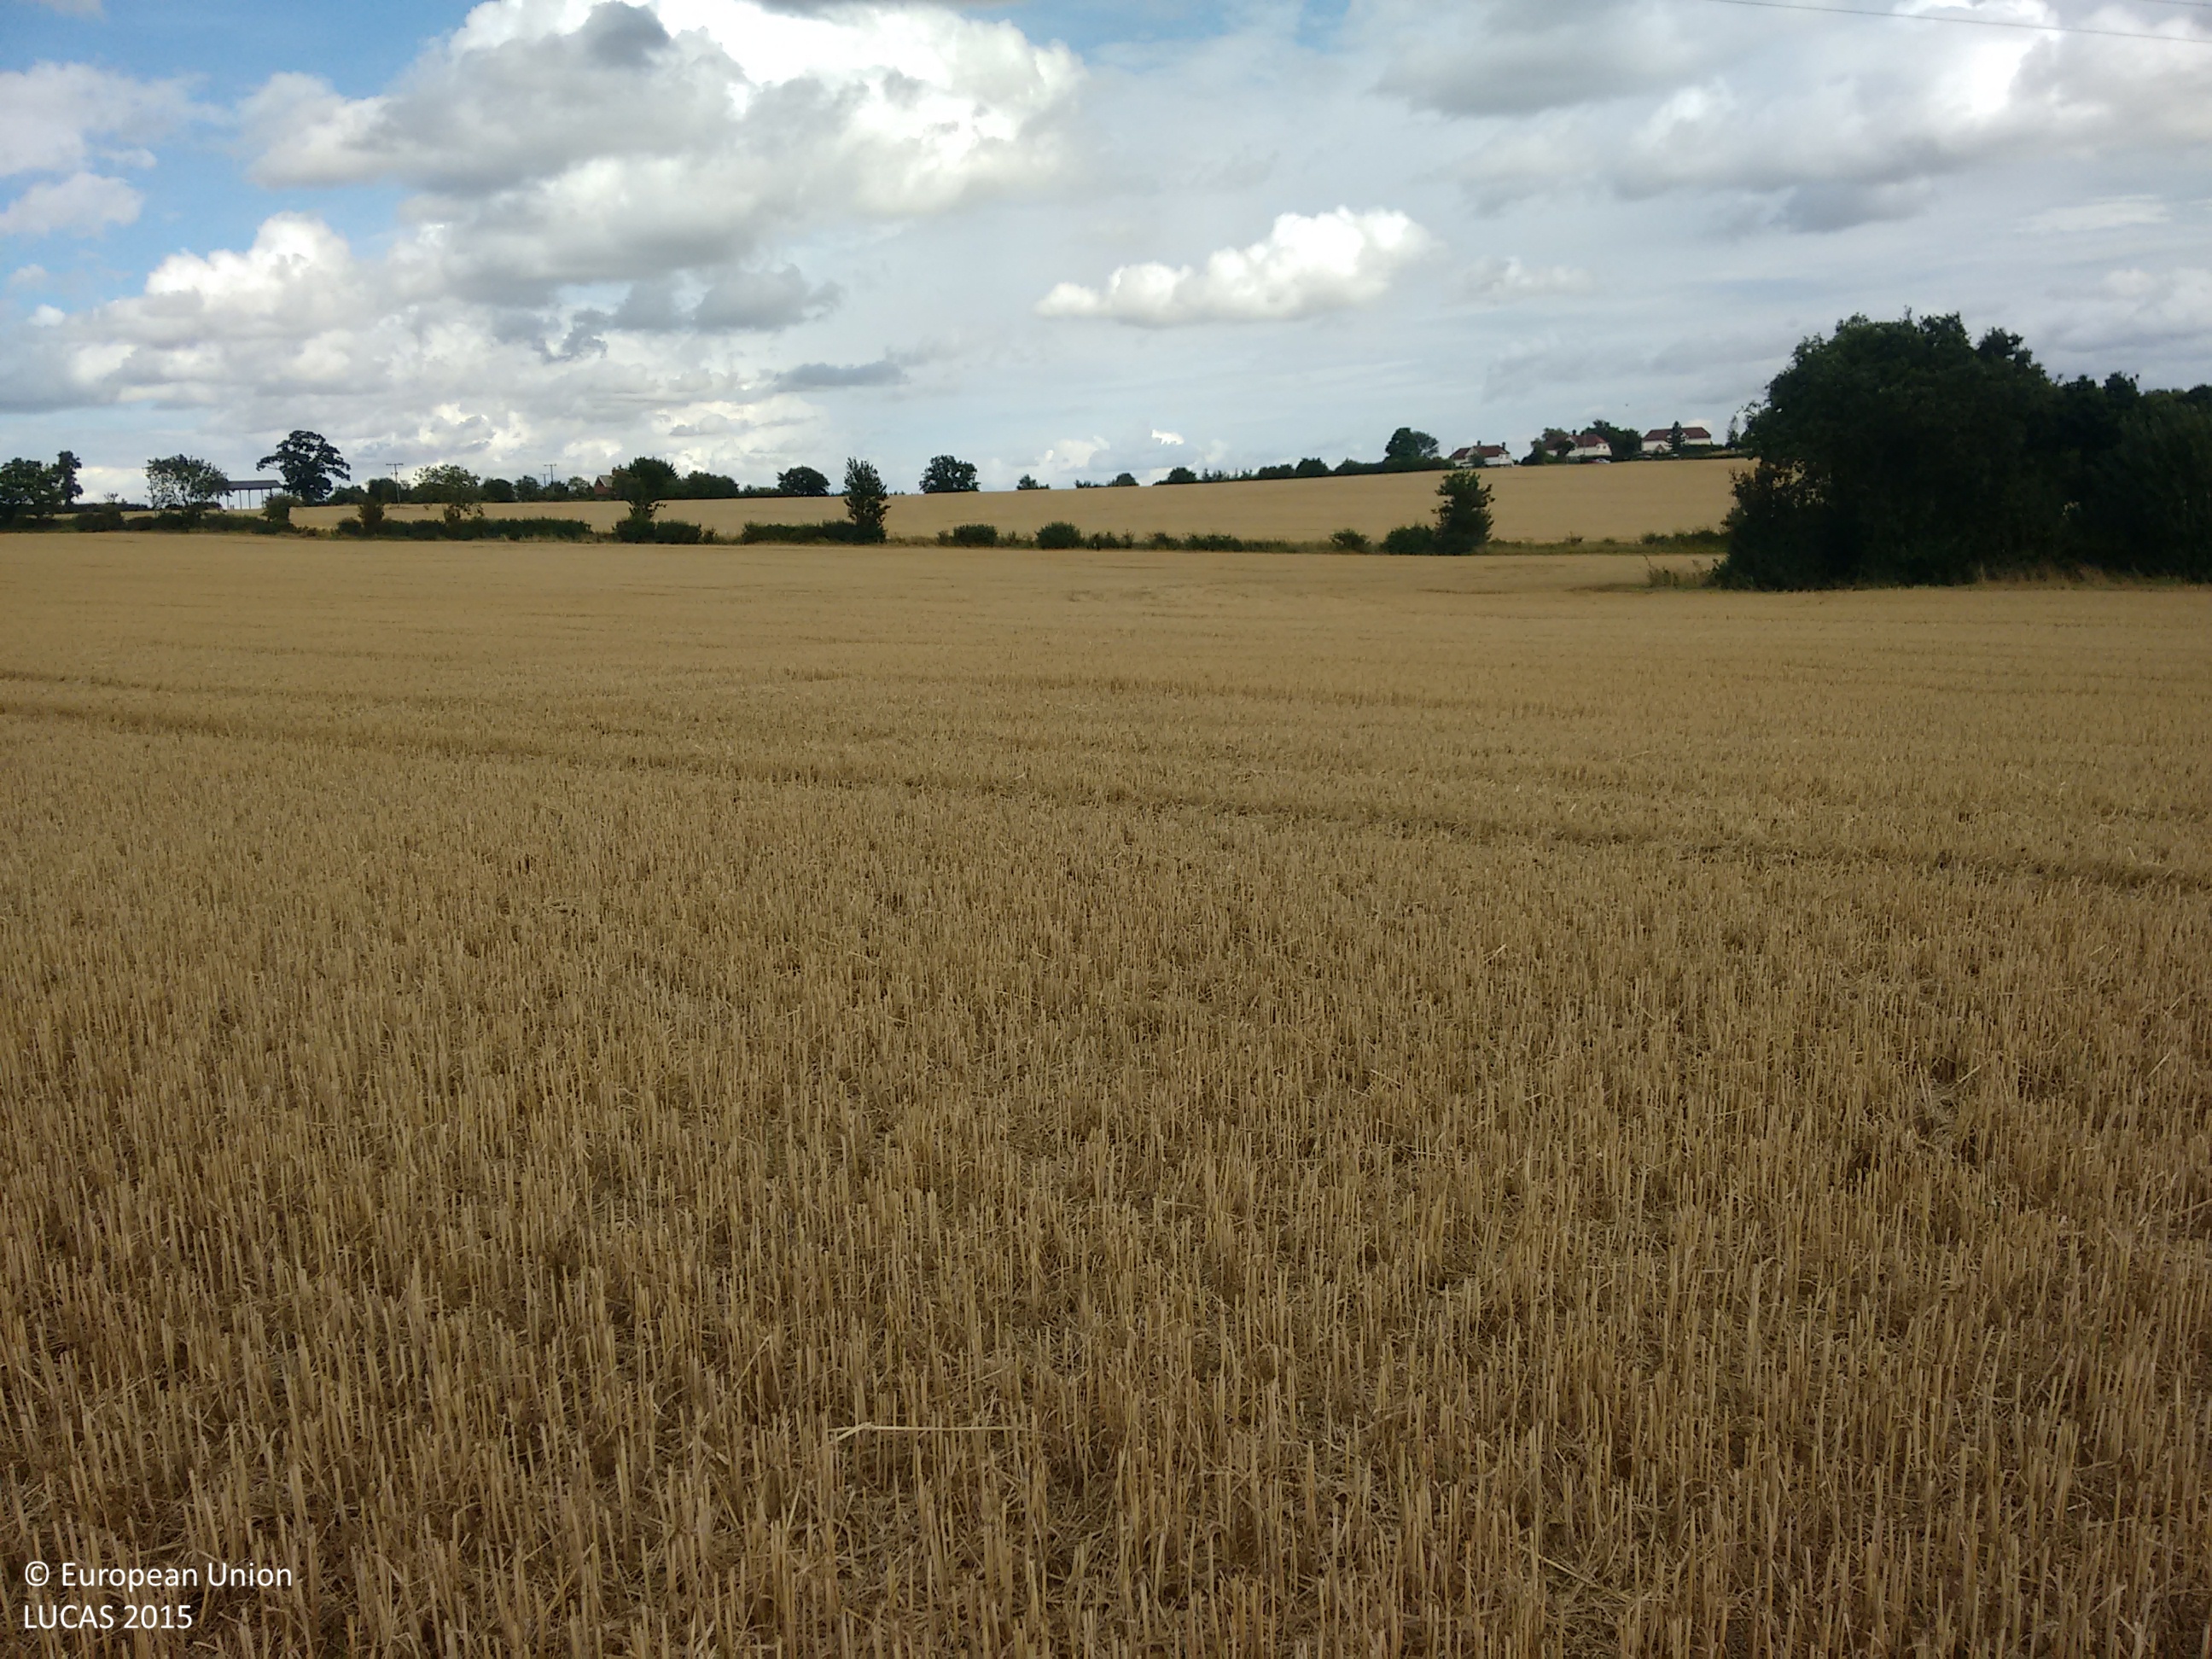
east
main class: Cropland
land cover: Common wheat
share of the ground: > 75 %
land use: Agriculture (excluding fallow land and kitchen gardens)
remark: Harvested field
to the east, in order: Common wheat; Grass margins; Ditches and canals; Abandoned hedges; Grass margins; Common wheat
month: August
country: GB
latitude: 52.1645
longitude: 0.5726
